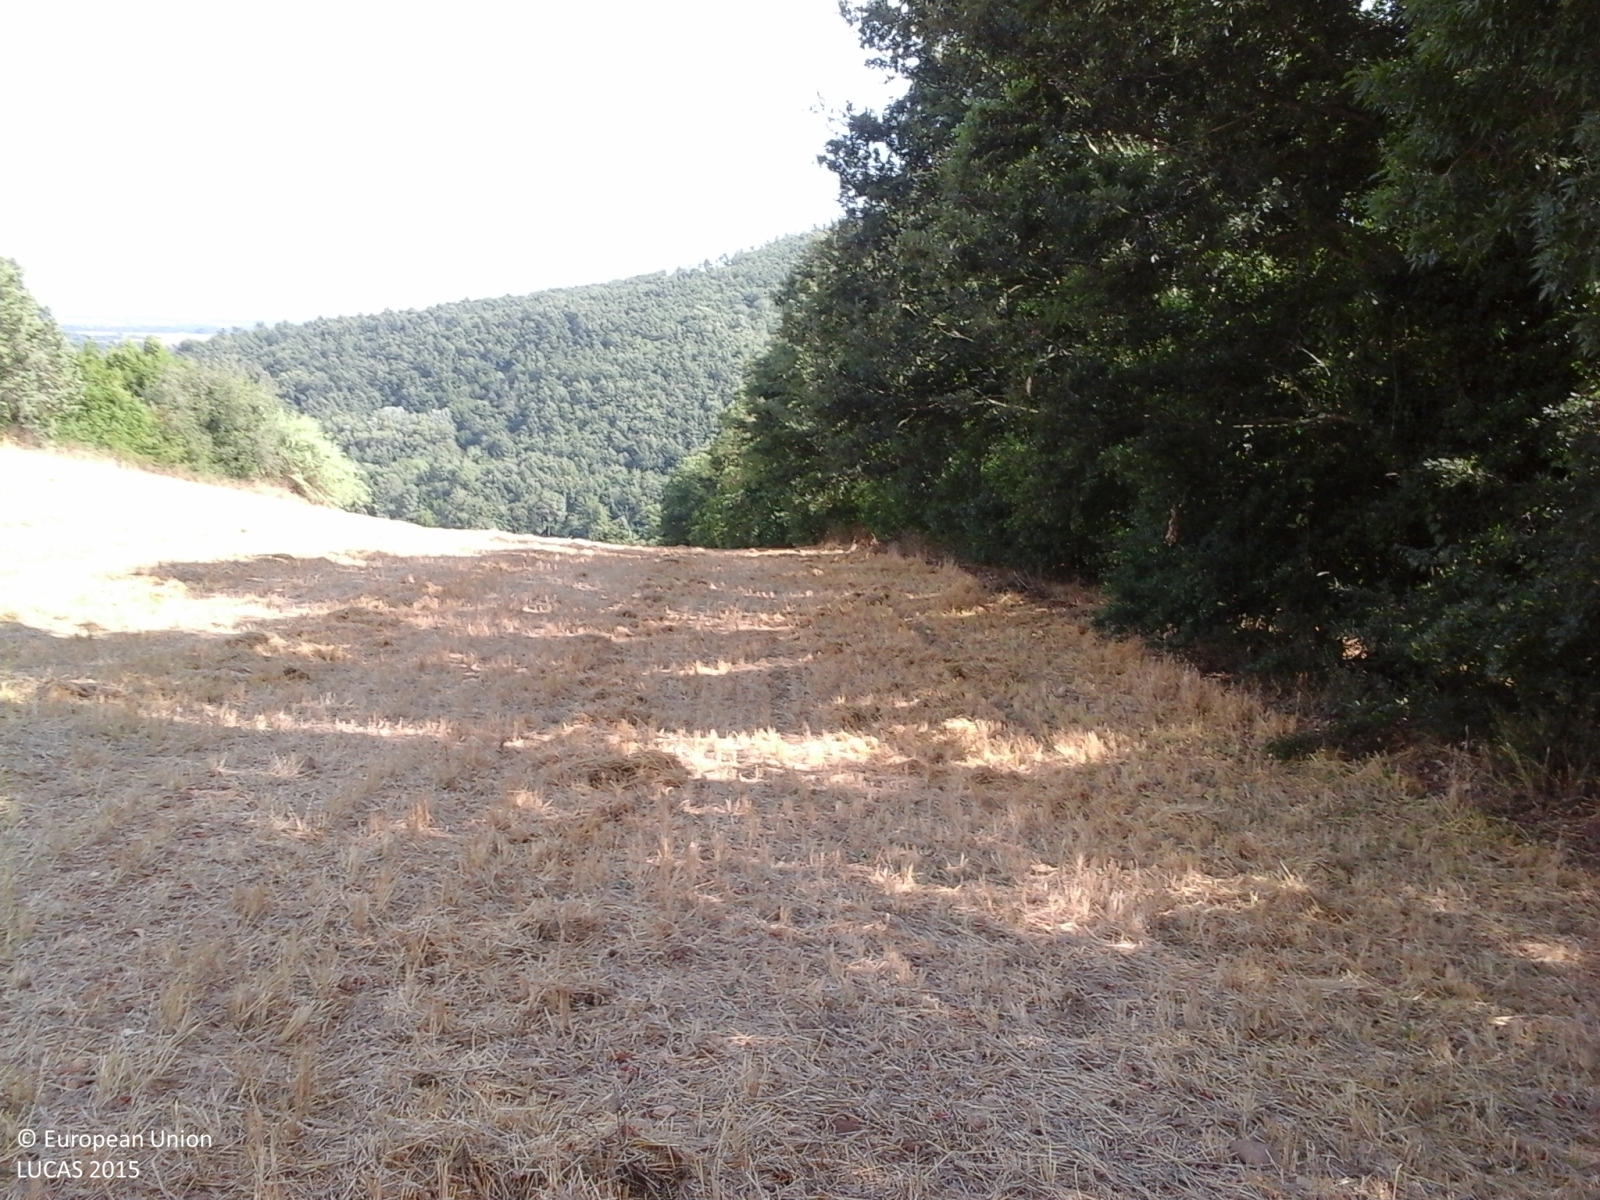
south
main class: Cropland
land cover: Barley
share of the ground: > 75 %
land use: Agriculture (excluding fallow land and kitchen gardens)
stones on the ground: 25 - 50 %
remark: Harvested field
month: August
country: IT
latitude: 42.5697
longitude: 11.5662
